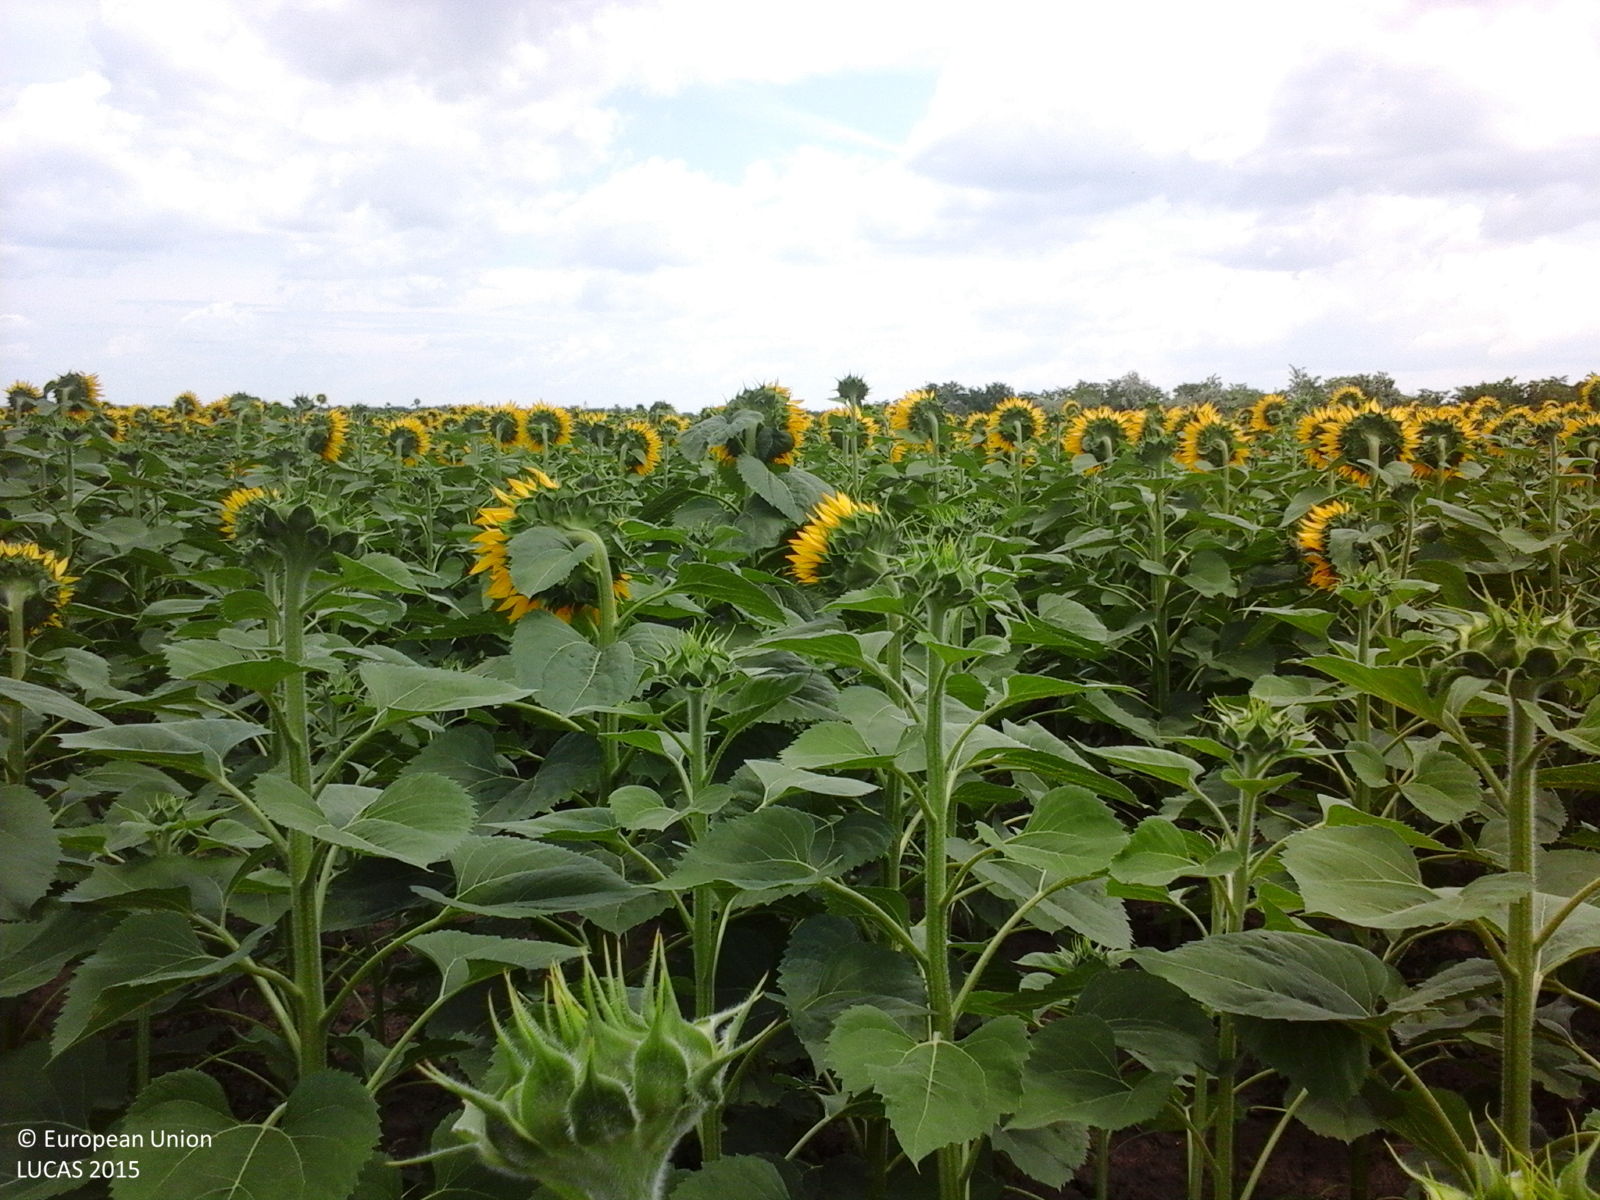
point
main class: Cropland
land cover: Sunflower
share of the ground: > 75 %
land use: Agriculture (excluding fallow land and kitchen gardens)
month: July
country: RO
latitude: 43.8959
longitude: 24.0882
